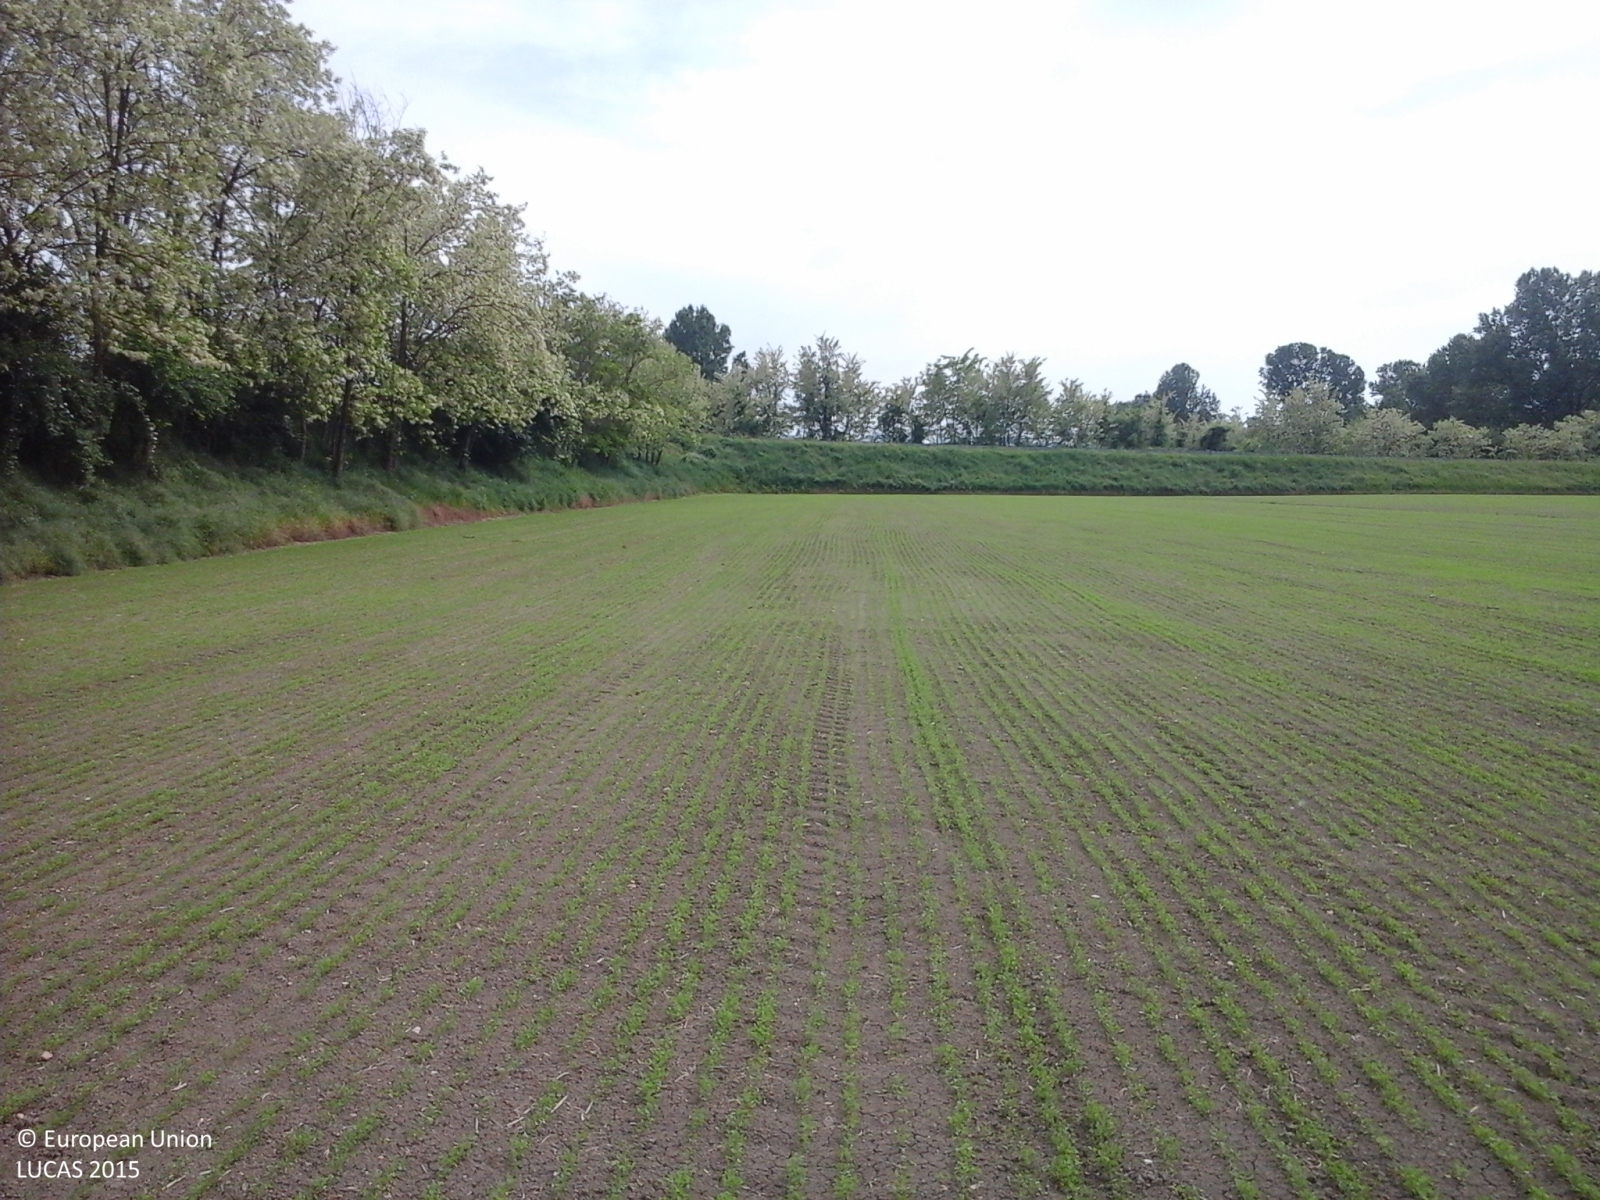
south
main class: Cropland
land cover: Lucerne
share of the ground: < 10 %
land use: Agriculture (excluding fallow land and kitchen gardens)
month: May
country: IT
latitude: 45.0686
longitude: 9.1760
